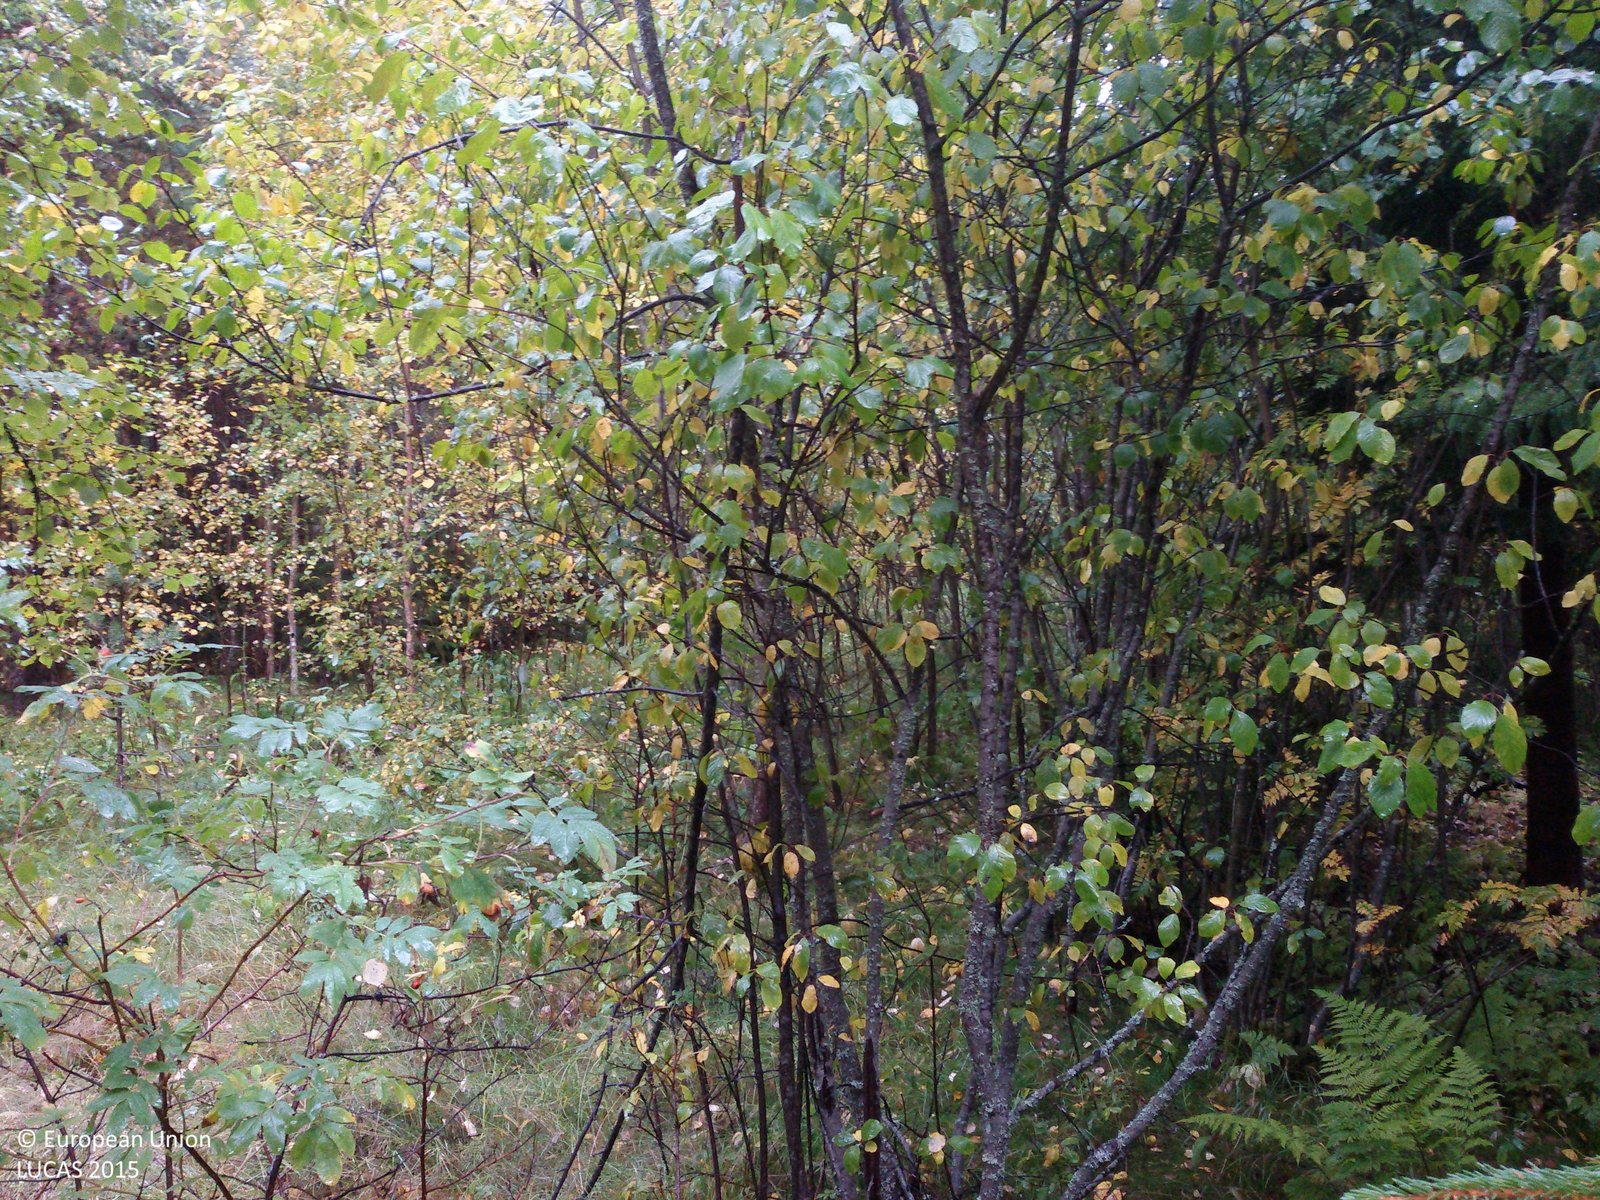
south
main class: Woodland
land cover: Spruce dominated mixed woodland
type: boreal forest
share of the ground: 50 - 75 %
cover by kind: coniferous forest trees 40 %, broadleaved forest trees 30 %, herbaceous plants 20 %, shrubs 10 %
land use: Amenities, museums, leisure
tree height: > 5 m
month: September
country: SE
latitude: 60.8822
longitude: 14.5742
